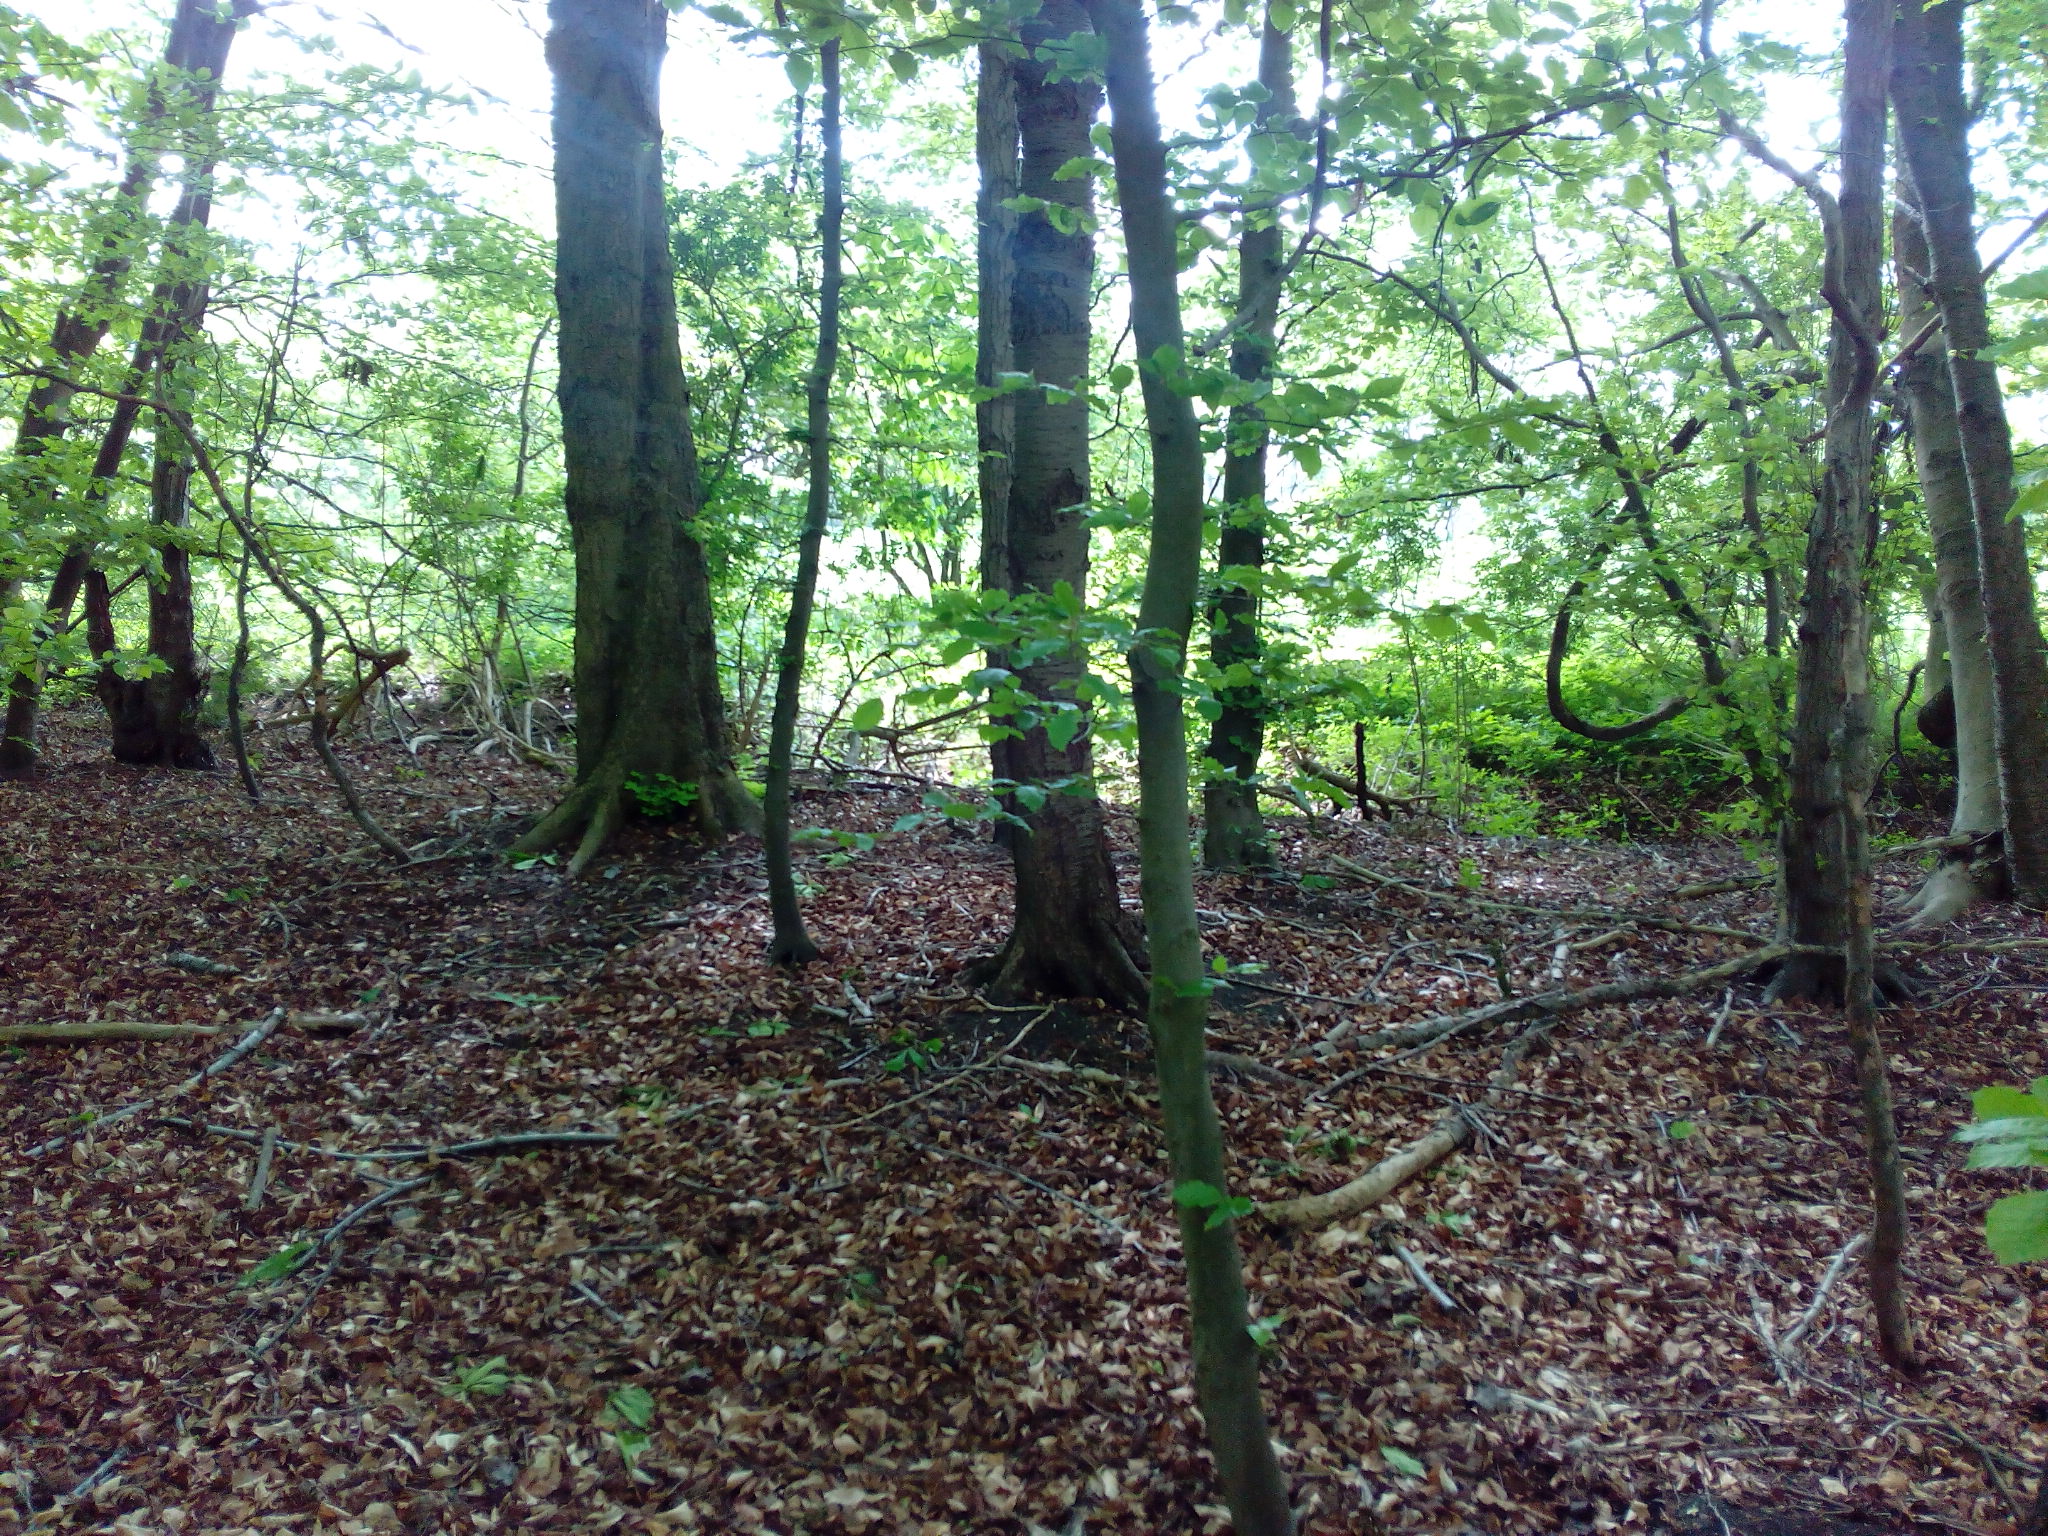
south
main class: Woodland
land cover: Broadleaved woodland
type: beech forest
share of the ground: > 75 %
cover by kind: broadleaved forest trees 95 %, herbaceous plants 5 %
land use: Forestry
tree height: > 5 m
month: May
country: DE
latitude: 52.3954
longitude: 9.8678
